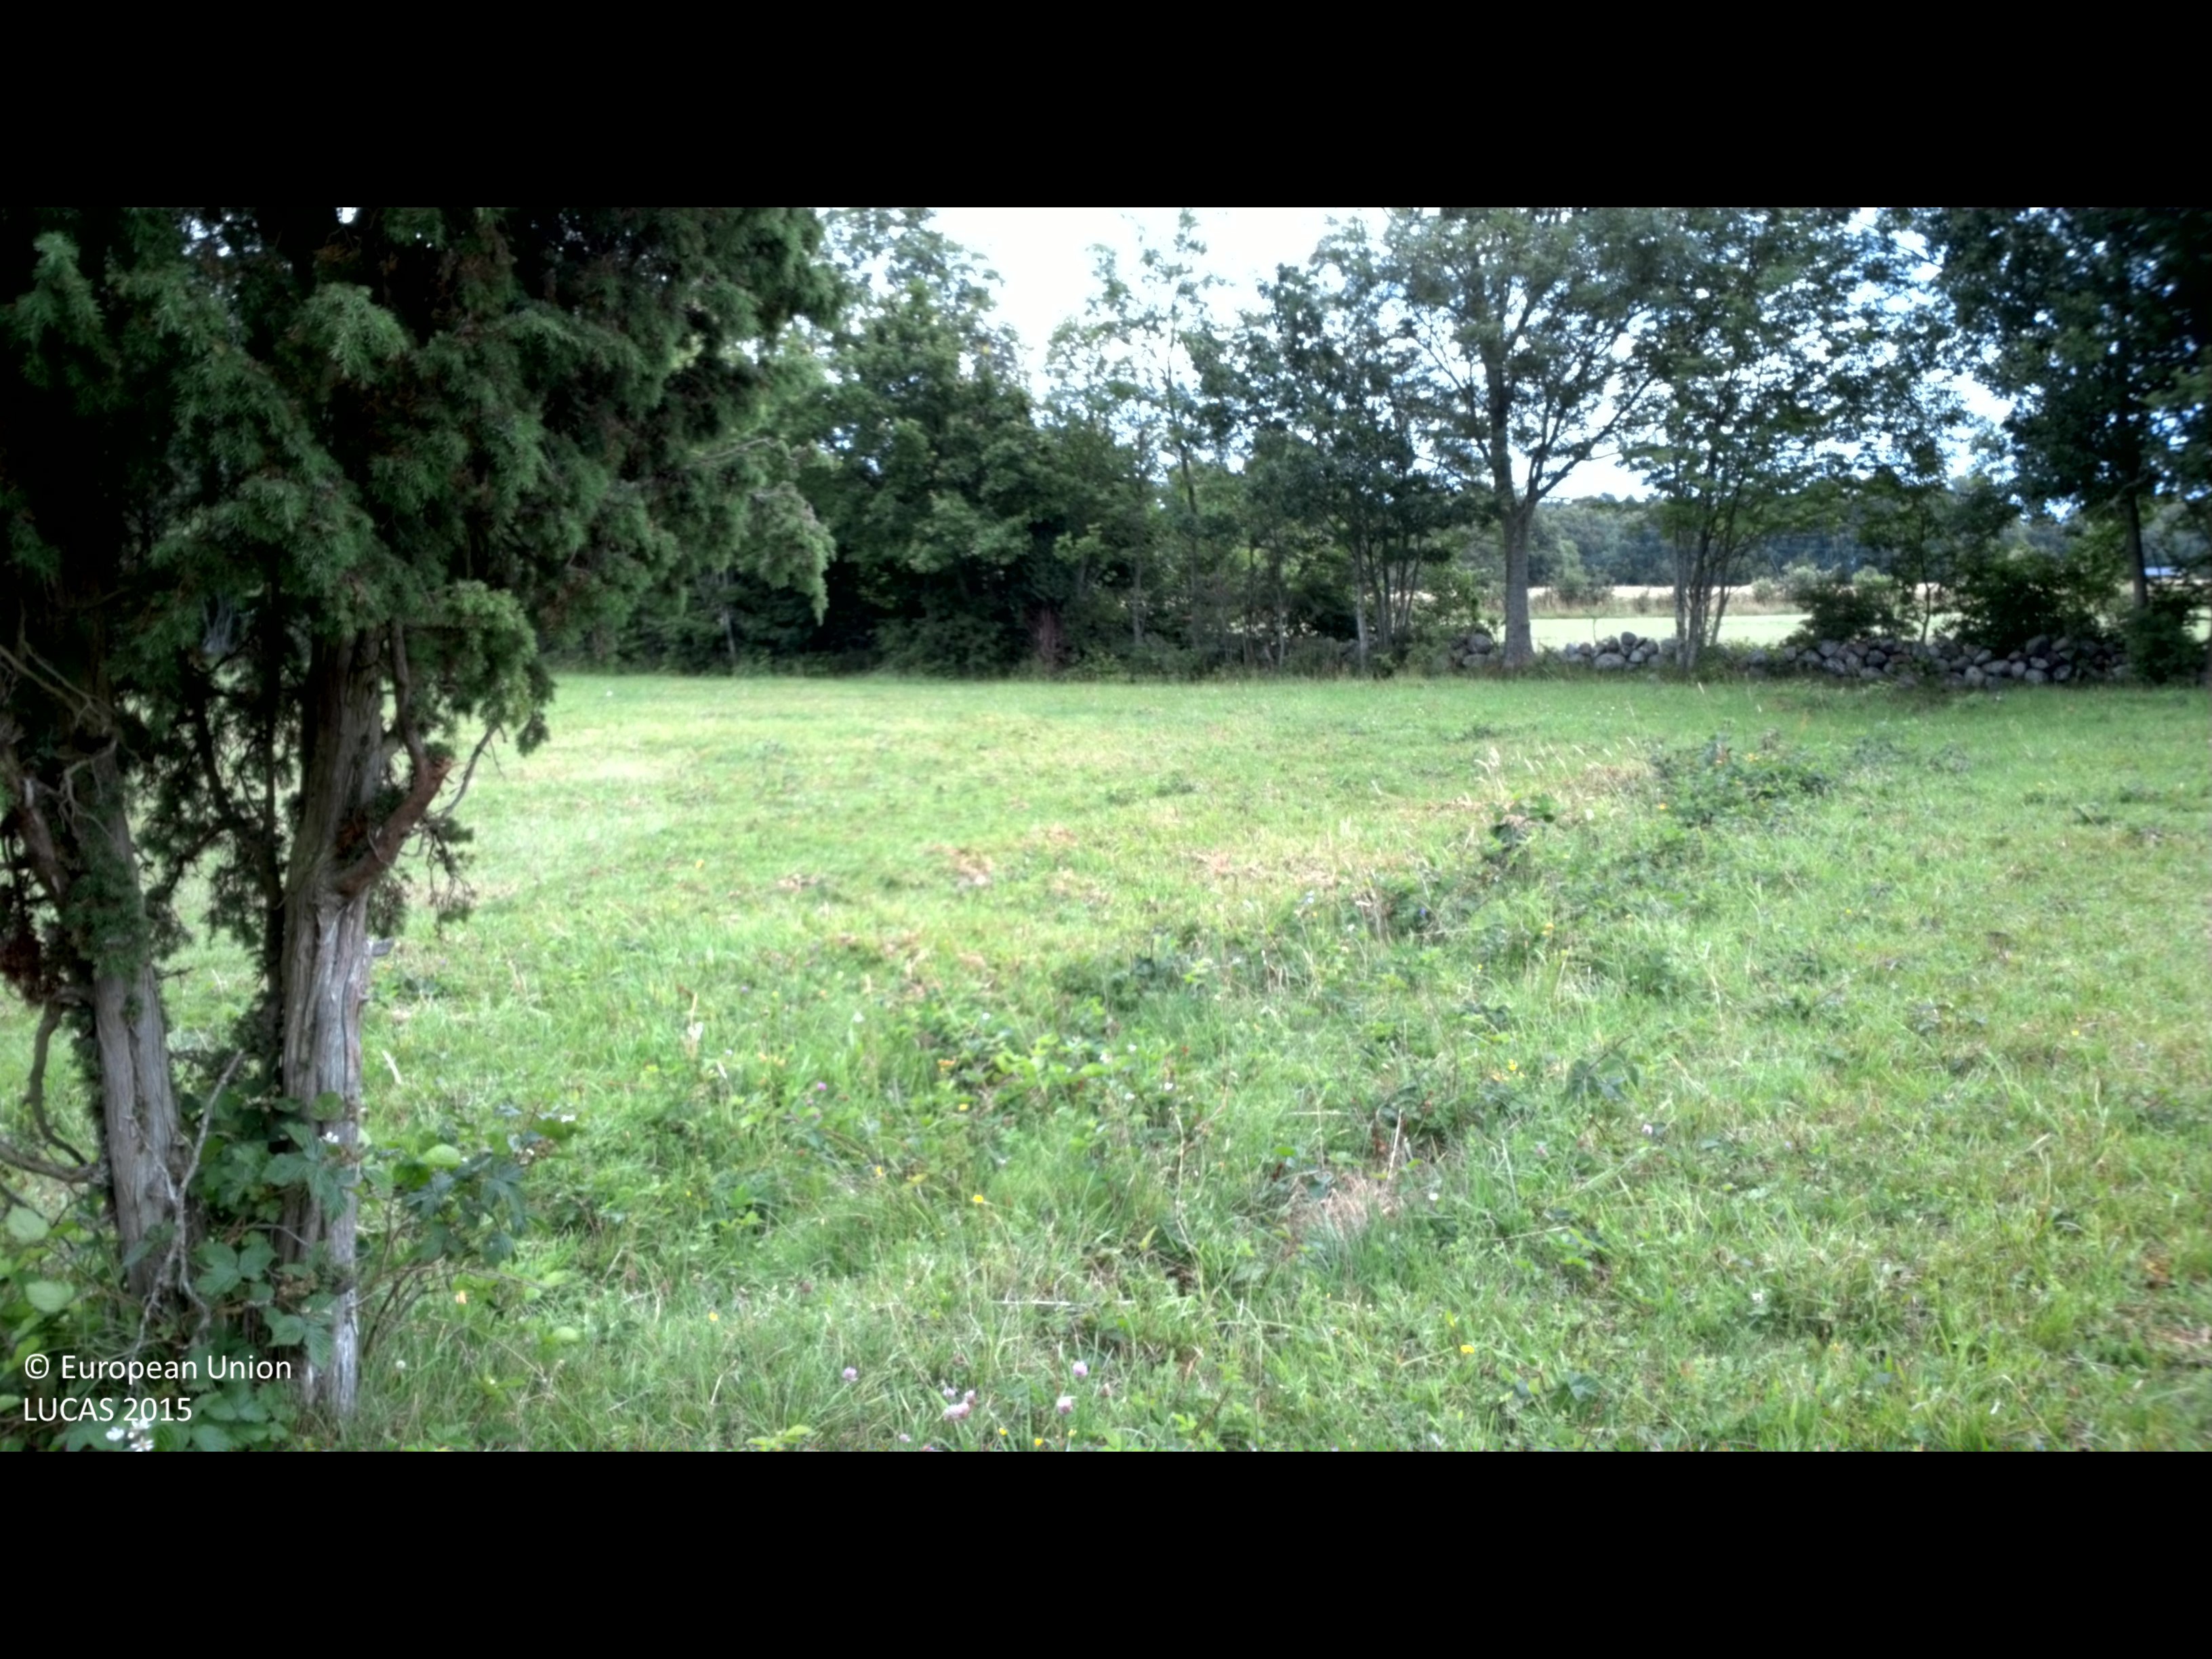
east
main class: Grassland
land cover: Grassland without tree/shrub cover
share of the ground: > 75 %
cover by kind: herbaceous plants 95 %, shrubs 5 %
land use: Agriculture (excluding fallow land and kitchen gardens)
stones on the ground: < 10 %
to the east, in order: Grassland without tree/shrub cover; Dry stone walls; Fences; Groves; Grassland without tree/shrub cover; Shruby margins; Fences; Grass margins; Tracks; Shruby margins; Fences; Barley; Abandoned hedges; Grass margins; Paved roads, cycling and walking lanes; Grass margins; Fences; Grassland without tree/shrub cover; Artificial constructions in urban areas
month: July
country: SE
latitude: 57.1864
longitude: 17.0338
